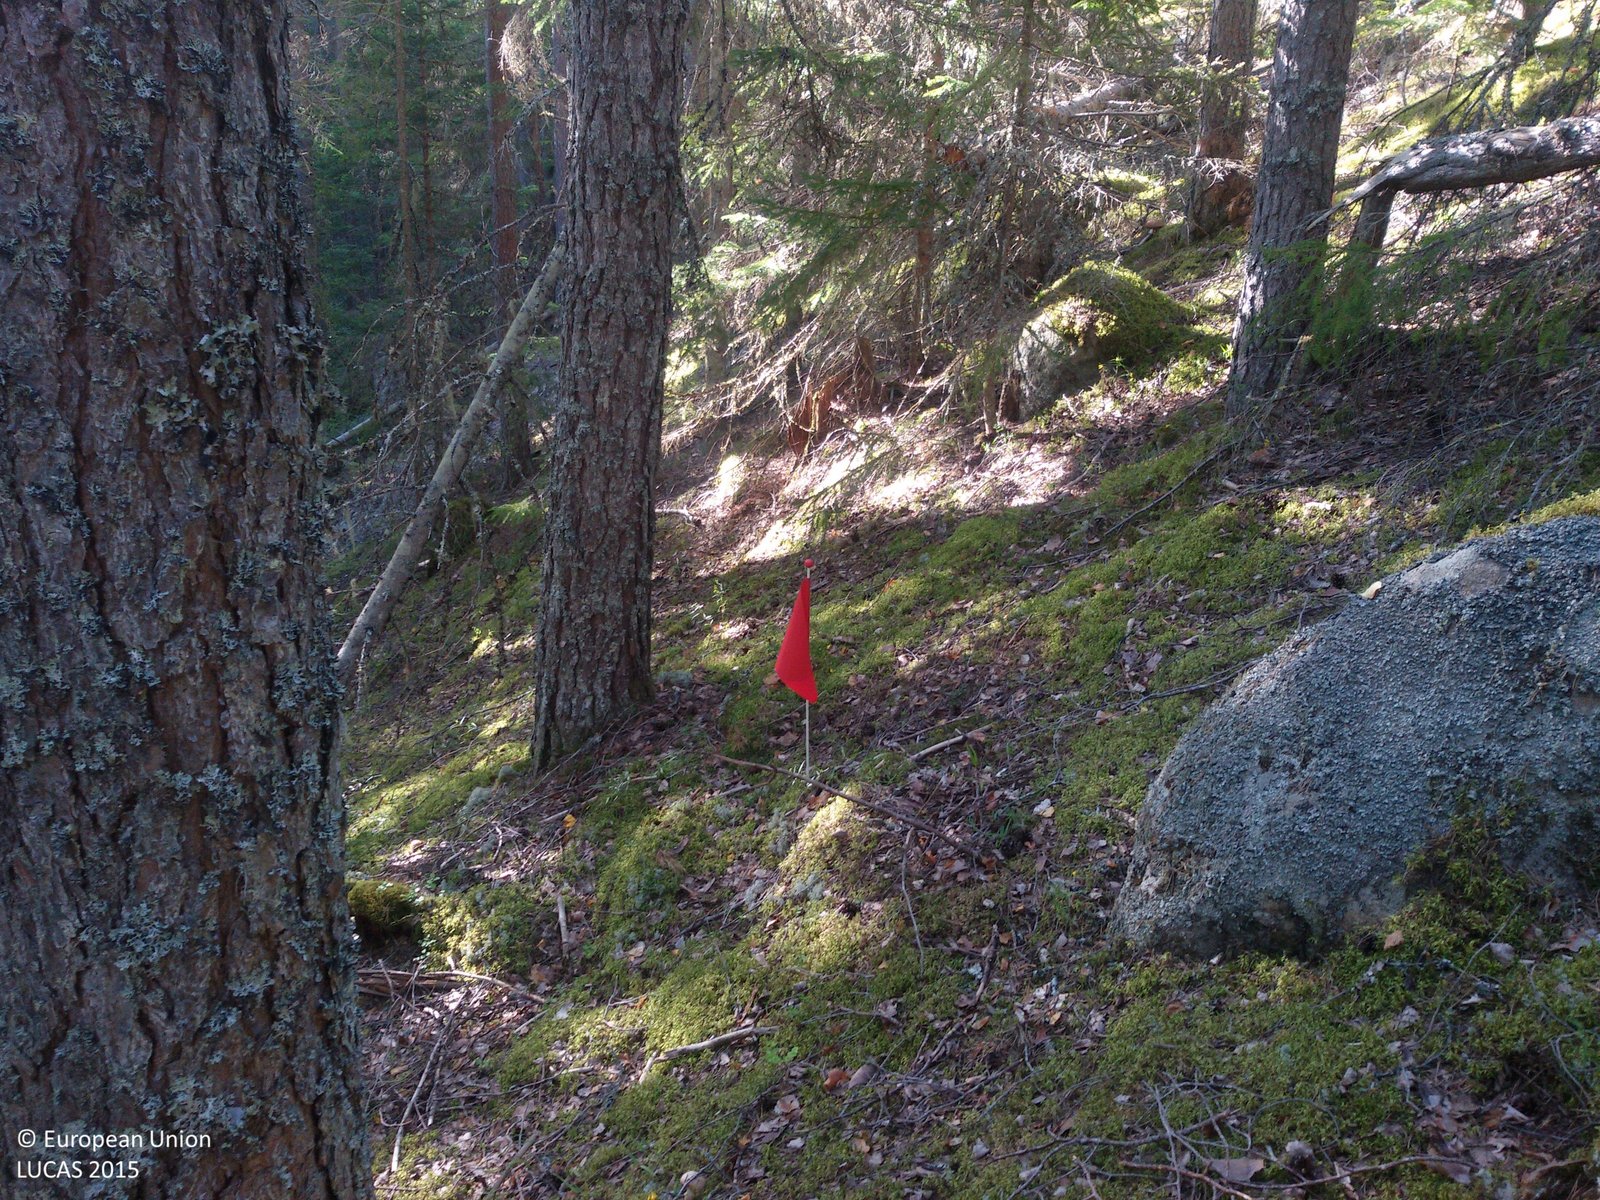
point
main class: Woodland
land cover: Spruce dominated coniferous woodland
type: boreal forest
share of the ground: 50 - 75 %
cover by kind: coniferous forest trees 65 %, lichens and mosses 20 %, herbaceous plants 10 %, broadleaved forest trees 5 %
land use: Amenities, museums, leisure
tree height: > 5 m
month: August
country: SE
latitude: 60.7374
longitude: 16.4614
